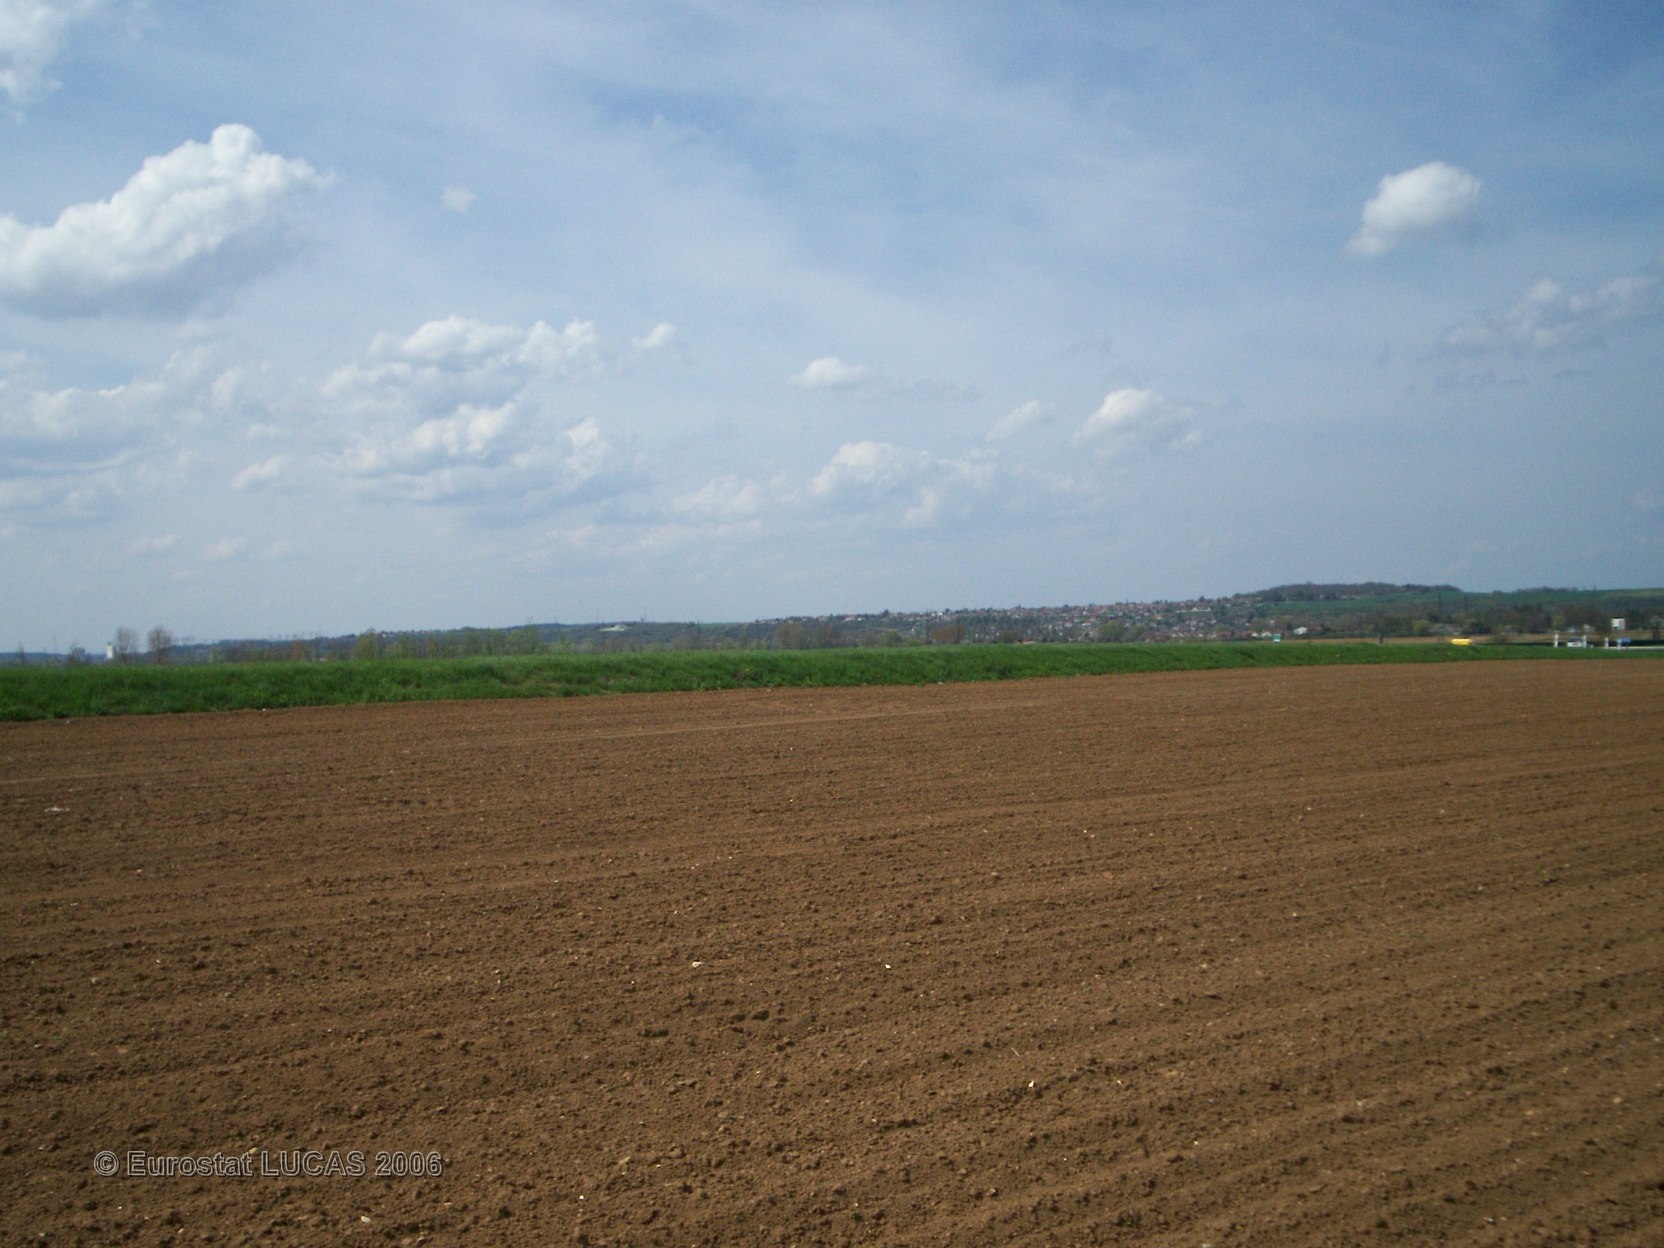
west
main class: Cropland
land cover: Sugar beet
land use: Agriculture (excluding fallow land and kitchen gardens)
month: April
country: FR
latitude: 48.3579
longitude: 2.9334
